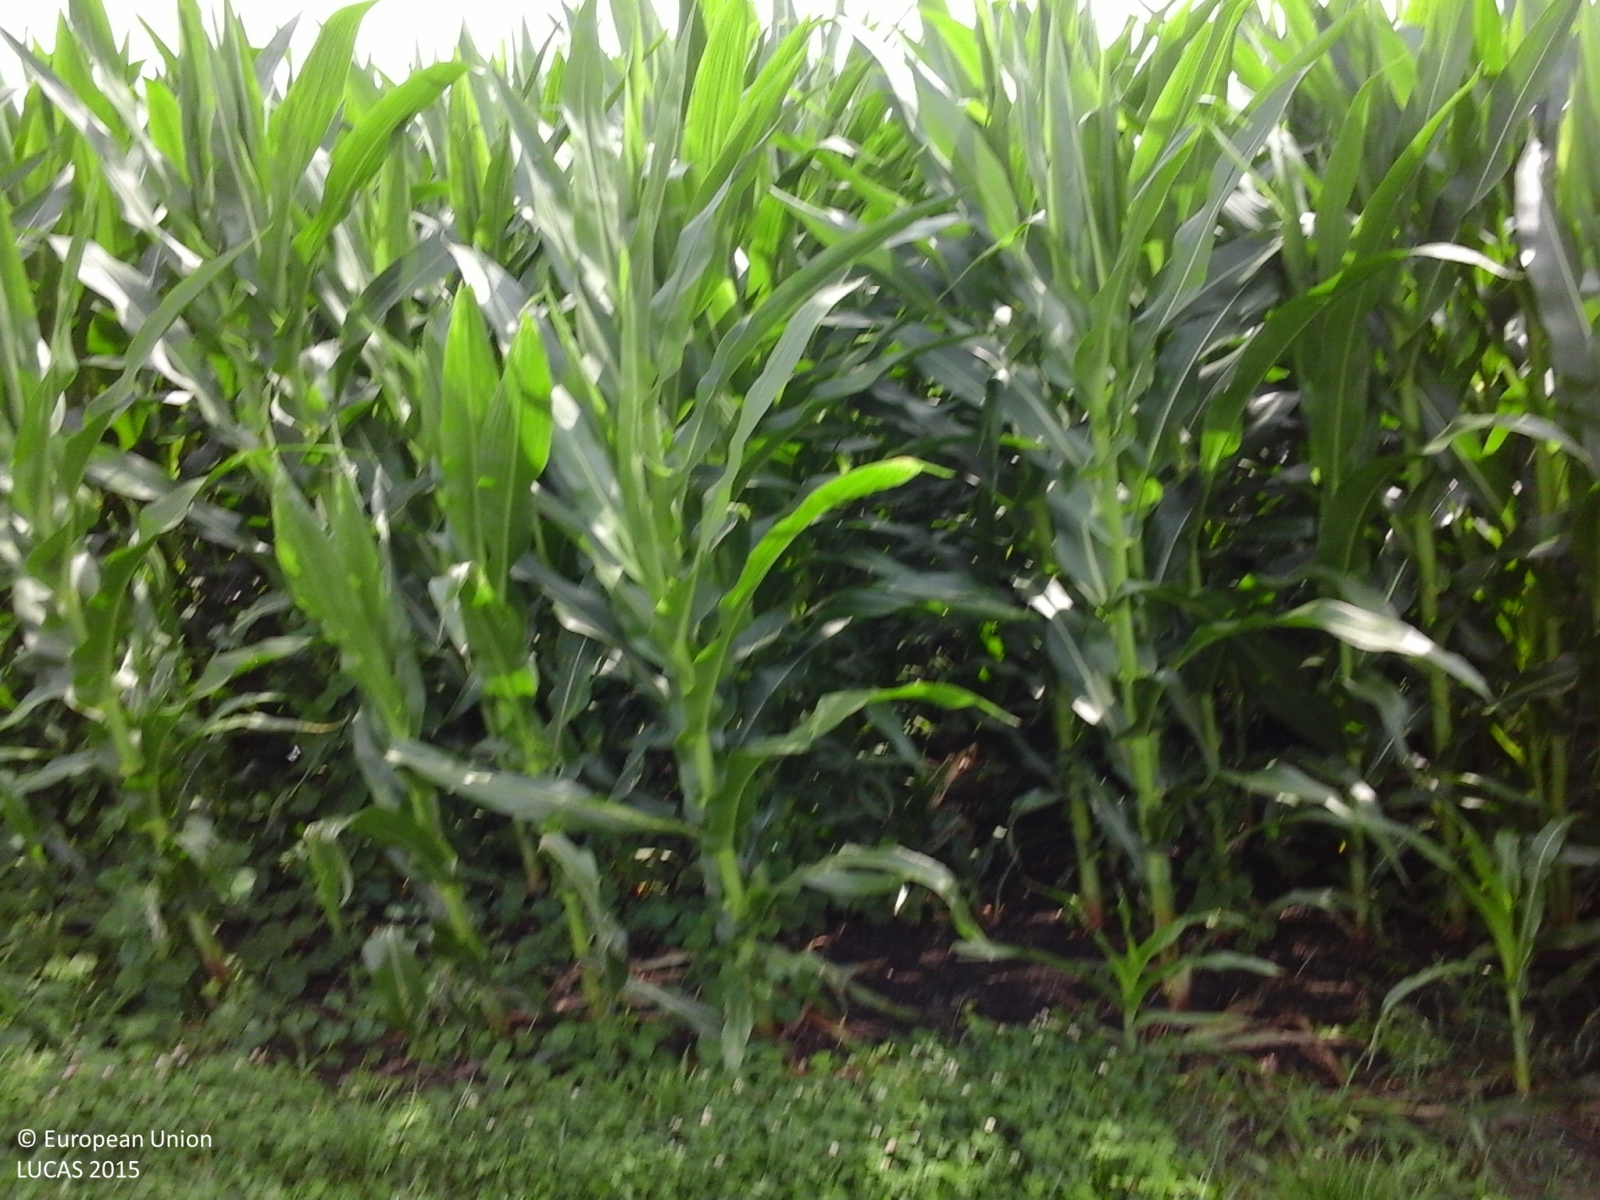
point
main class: Cropland
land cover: Maize
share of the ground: > 75 %
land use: Agriculture (excluding fallow land and kitchen gardens)
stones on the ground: < 10 %
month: June
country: IT
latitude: 45.9265
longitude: 12.4598
